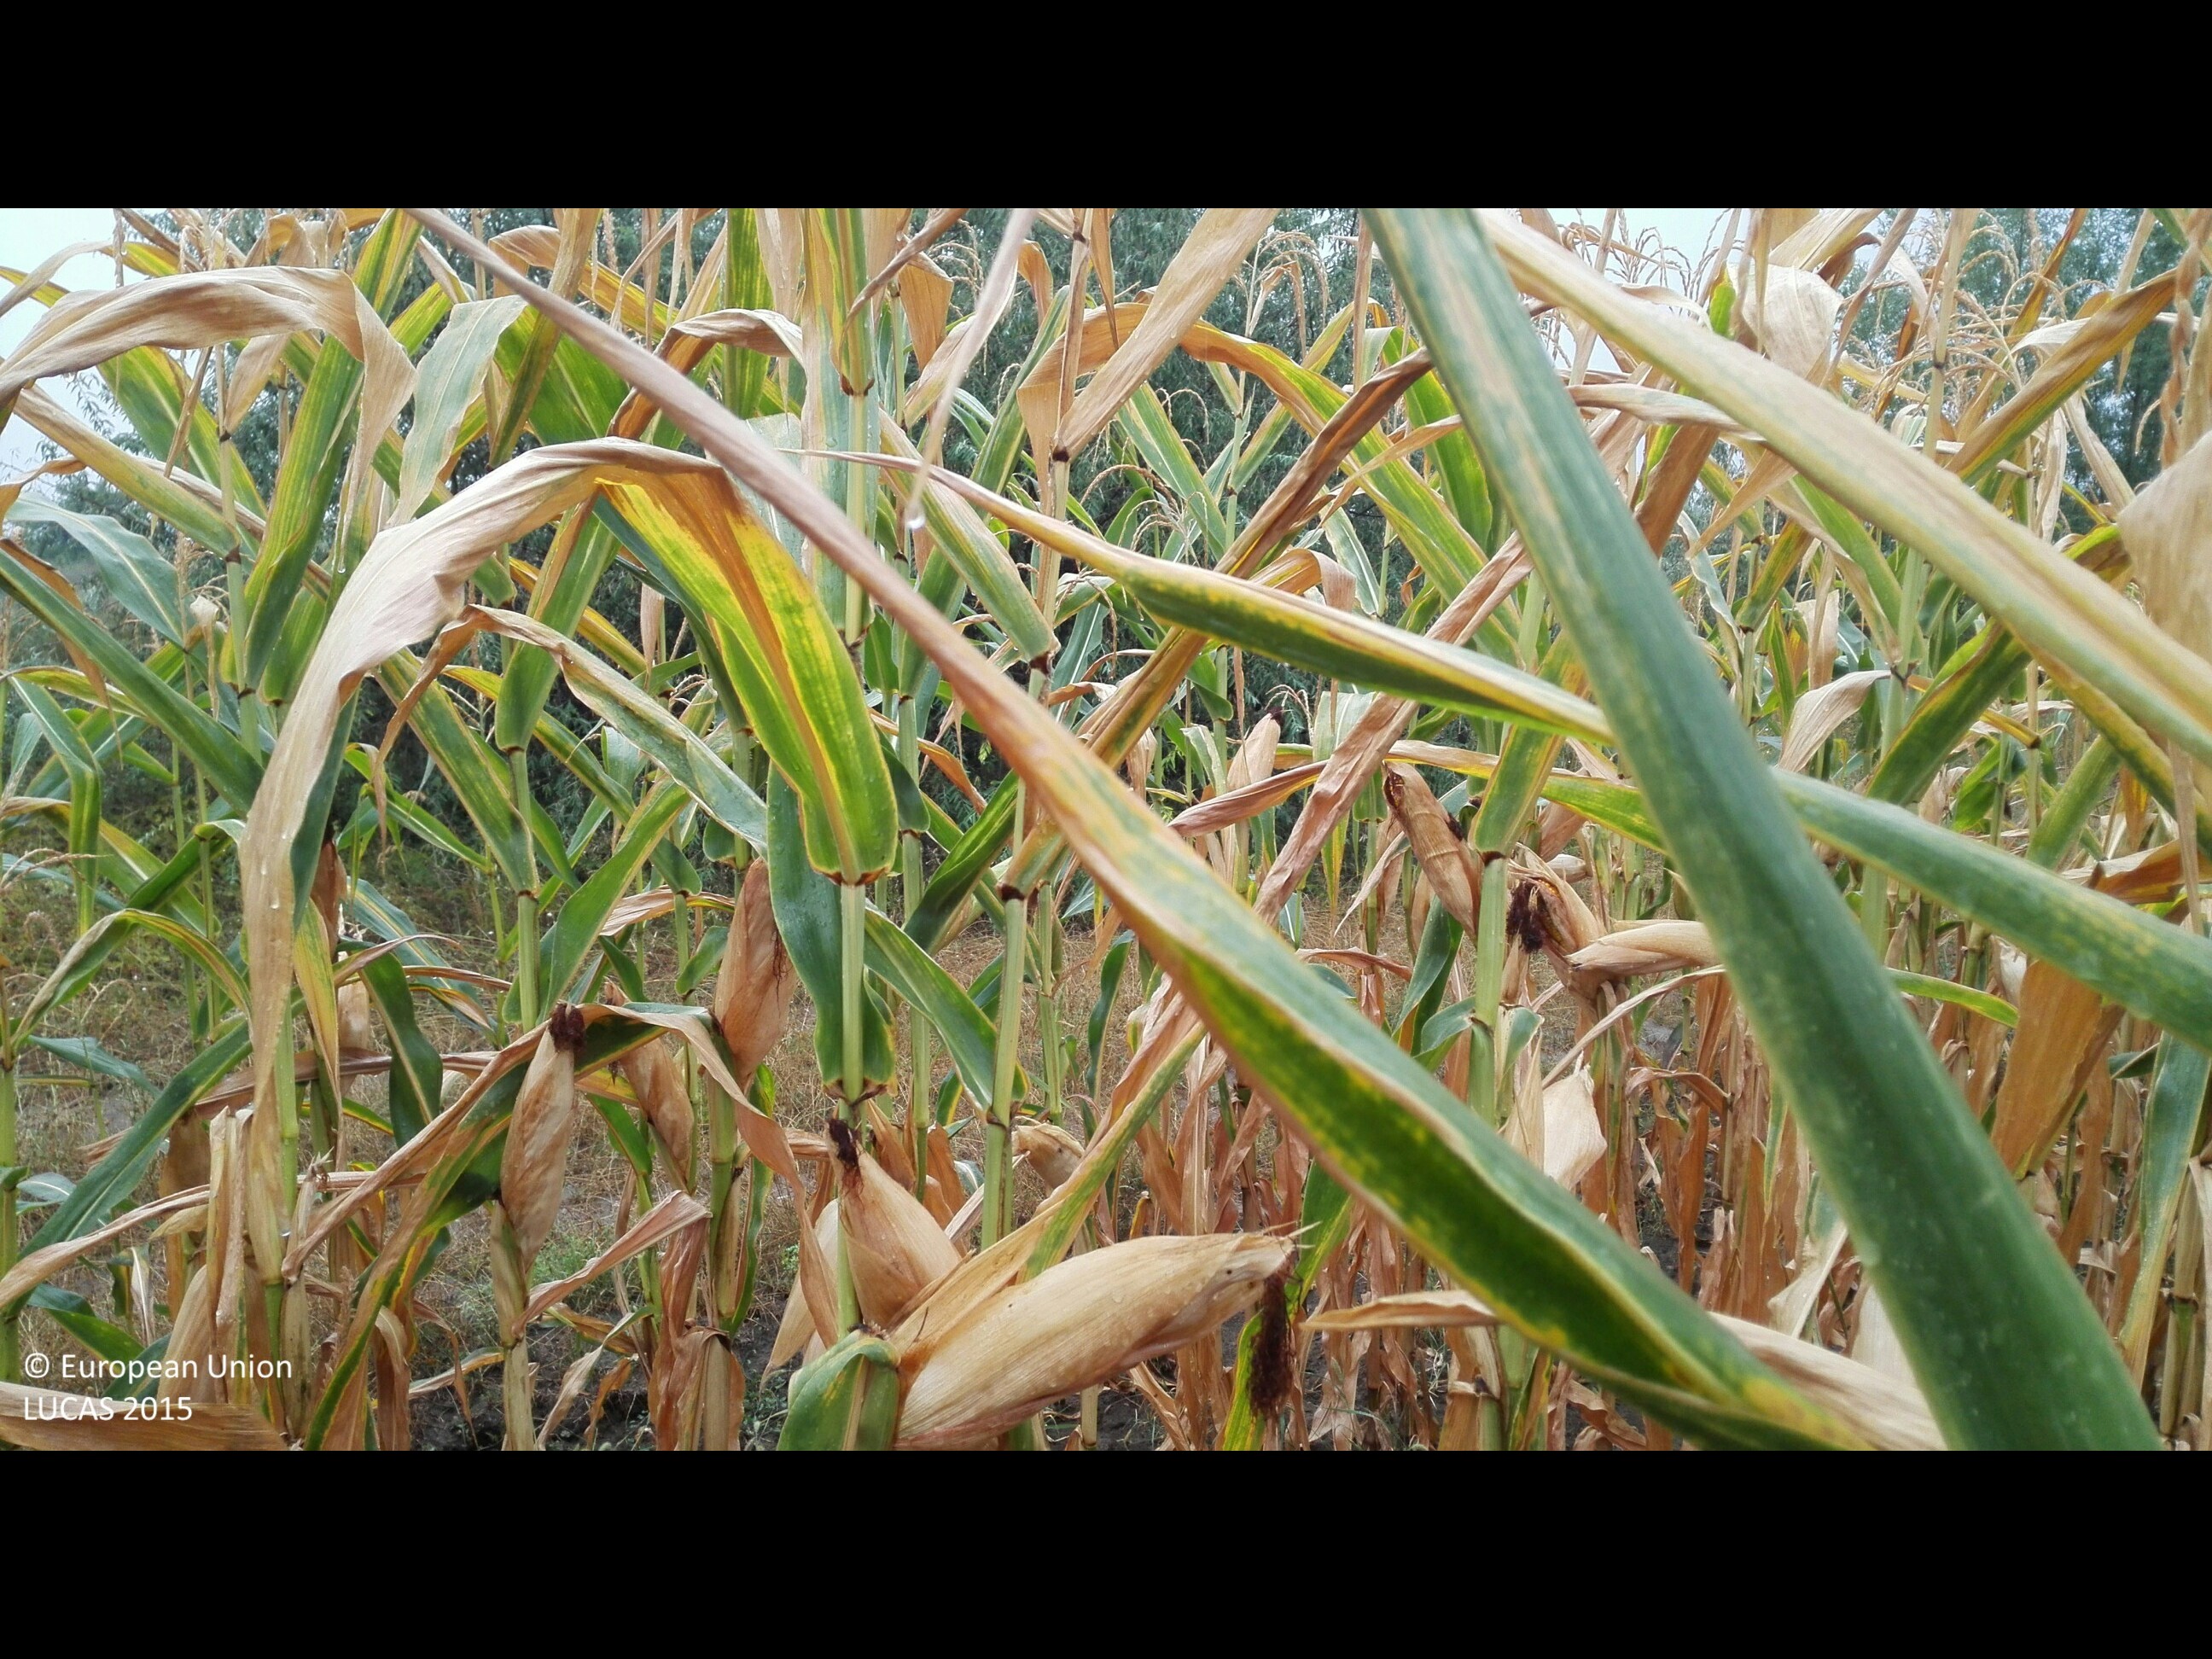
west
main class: Cropland
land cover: Maize
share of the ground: > 75 %
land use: Agriculture (excluding fallow land and kitchen gardens)
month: August
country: HU
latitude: 47.3699
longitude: 21.7923
